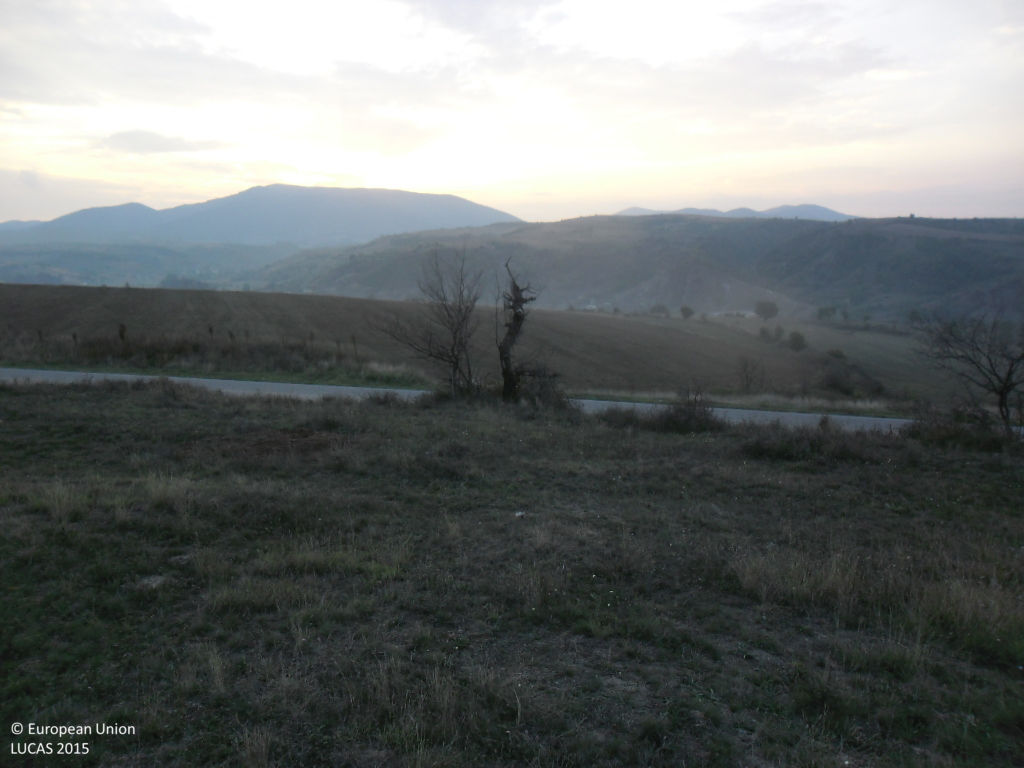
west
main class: Grassland
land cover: Grassland without tree/shrub cover
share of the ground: > 75 %
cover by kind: herbaceous plants 100 %
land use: Semi-natural and natural areas not in use
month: September
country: BG
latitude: 41.9386
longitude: 23.0123
